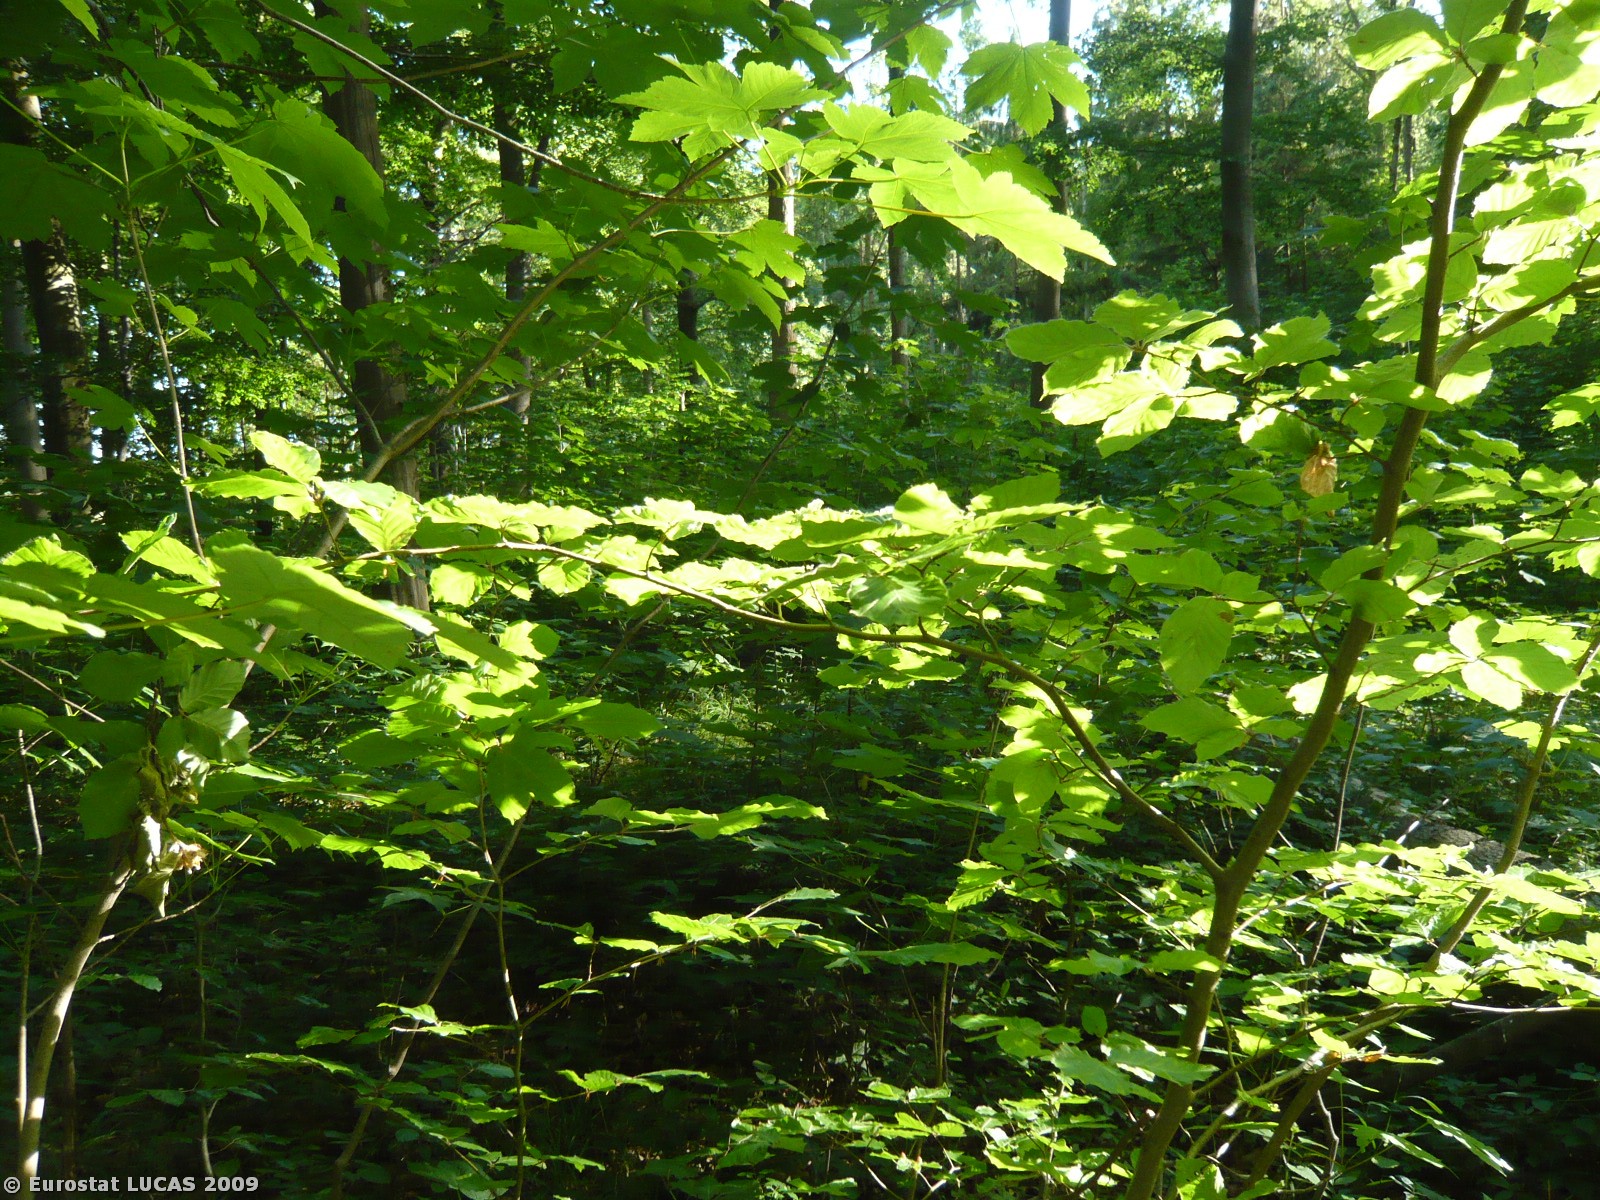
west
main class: Woodland
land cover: Broadleaved woodland
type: mesophytic deciduous forest
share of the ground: > 75 %
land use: Forestry
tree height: > 5 m
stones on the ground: < 10 %
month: June
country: DK
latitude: 54.8327
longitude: 11.3224
